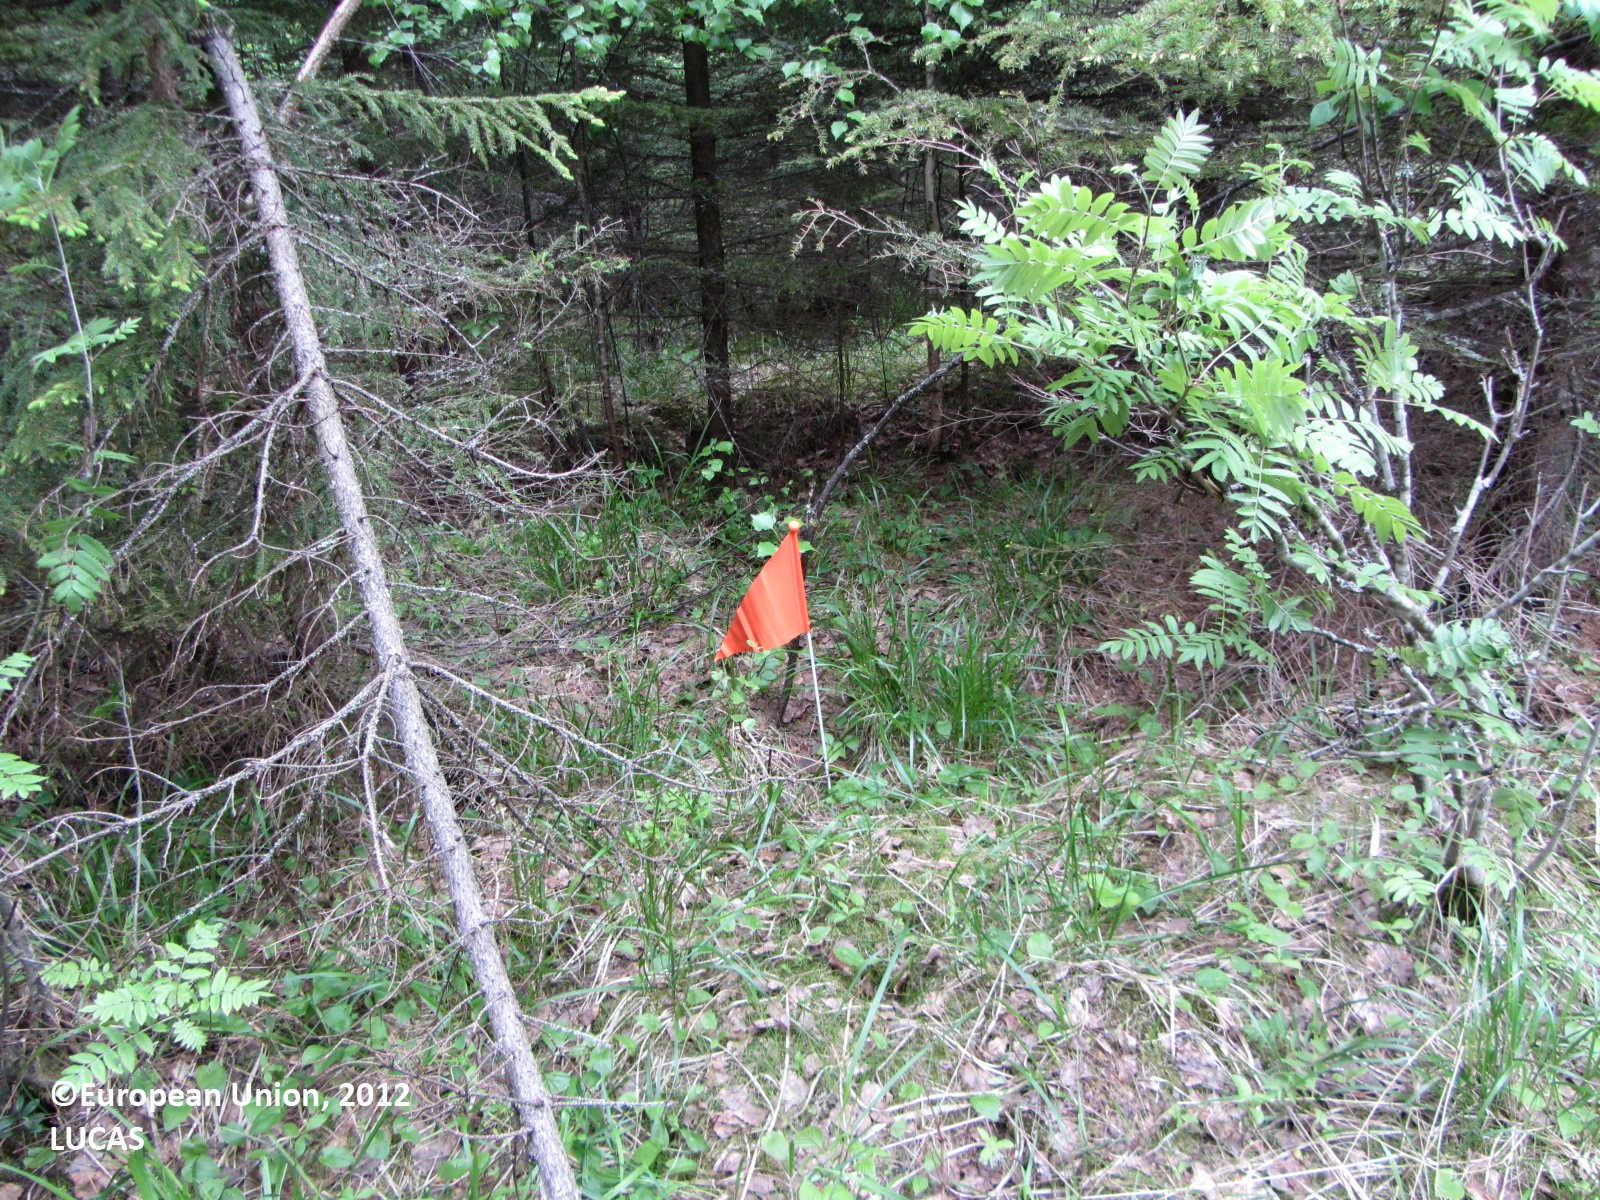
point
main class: Woodland
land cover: Spruce dominated coniferous woodland
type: boreal forest
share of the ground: 50 - 75 %
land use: Forestry
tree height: > 5 m
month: June
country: FI
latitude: 61.7722
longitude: 24.9068
